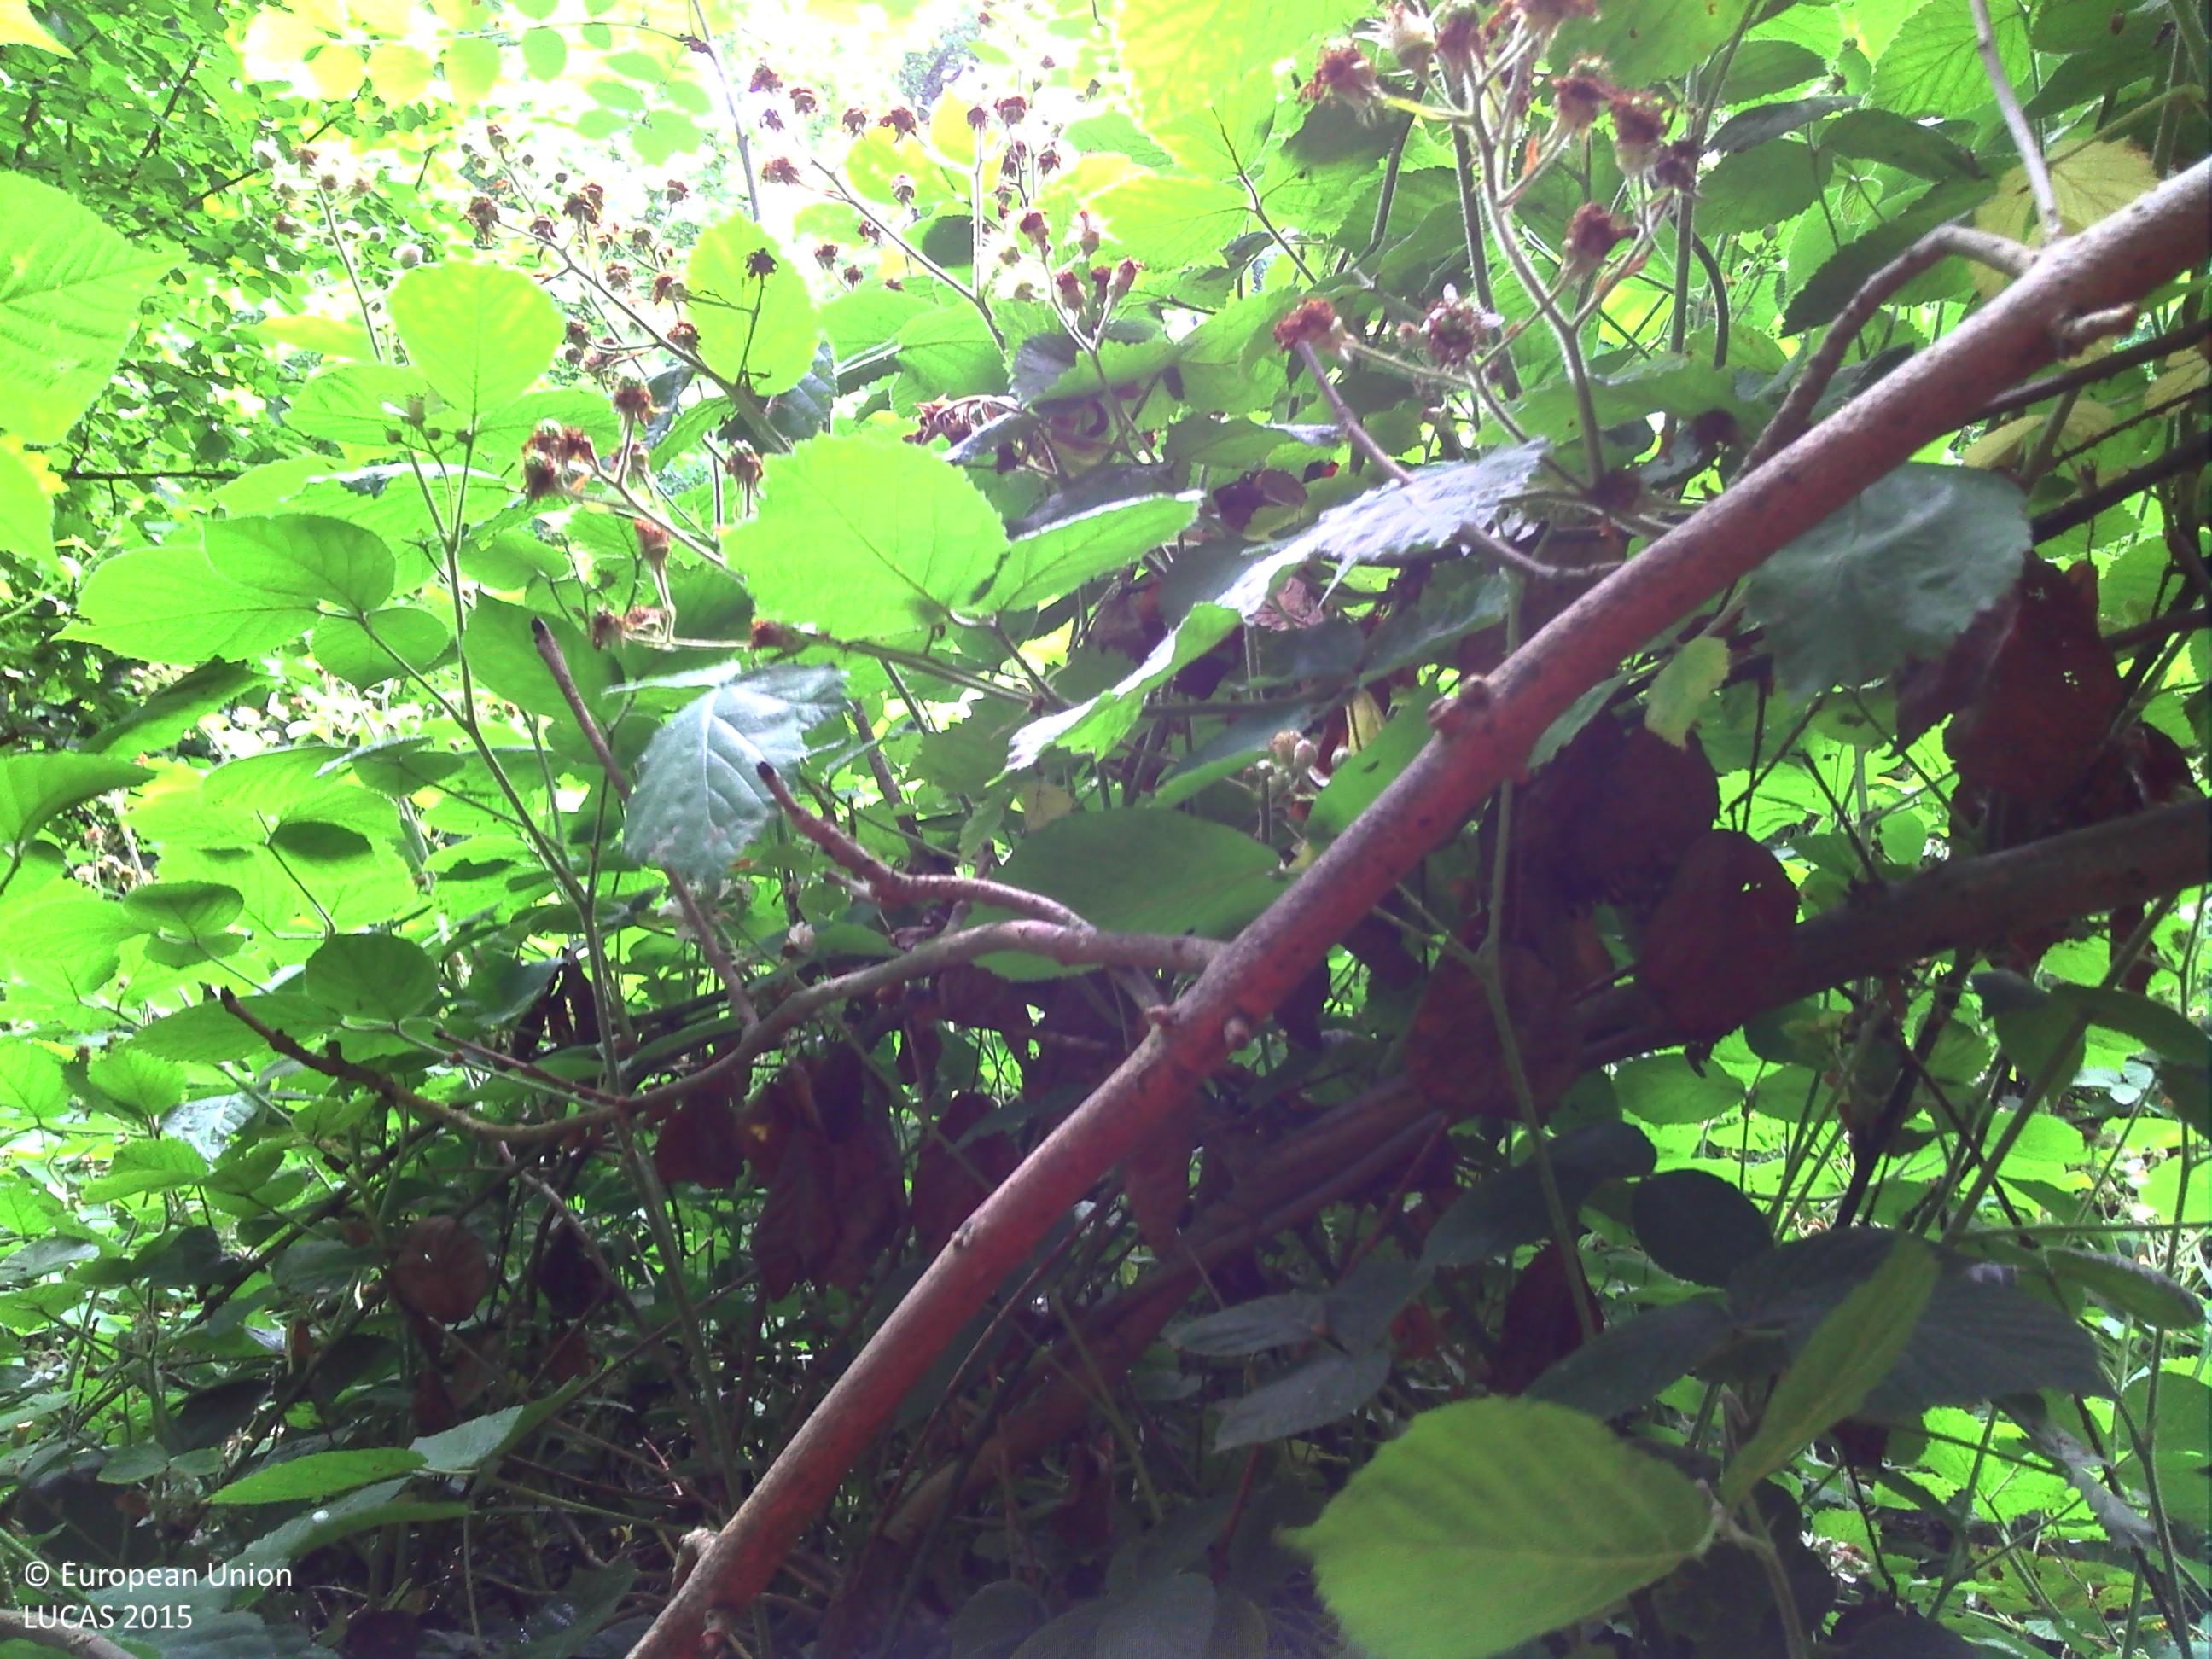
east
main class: Woodland
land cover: Broadleaved woodland
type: mesophytic deciduous forest
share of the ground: > 75 %
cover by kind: broadleaved forest trees 70 %, herbaceous plants 30 %
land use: Forestry
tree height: > 5 m
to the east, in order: Broadleaved woodland; Ditches and canals; Broadleaved woodland; Tracks; Grassland with sparse tree/shrub cover; Broadleaved woodland; Ditches and canals; Broadleaved woodland
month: June
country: BE
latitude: 50.9323
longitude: 5.2594
